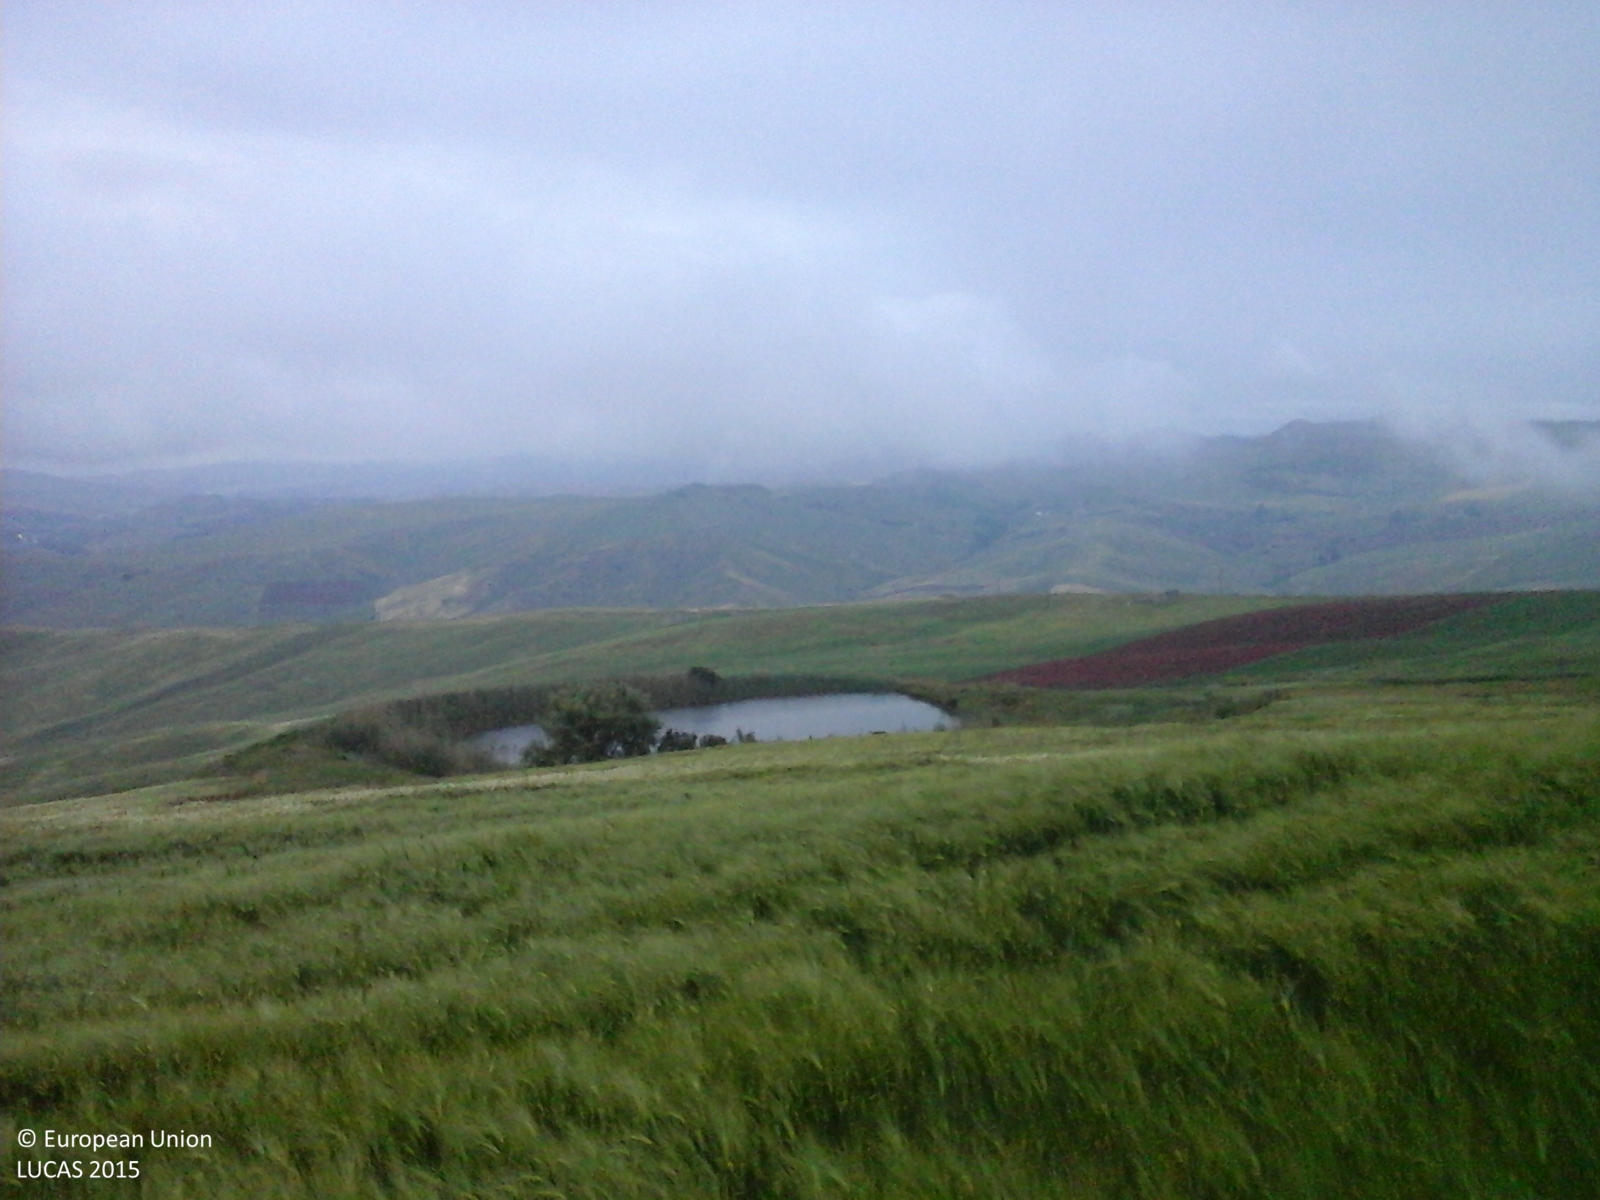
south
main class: Cropland
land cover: Barley
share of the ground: > 75 %
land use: Agriculture (excluding fallow land and kitchen gardens)
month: May
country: IT
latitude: 37.7542
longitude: 14.0004
